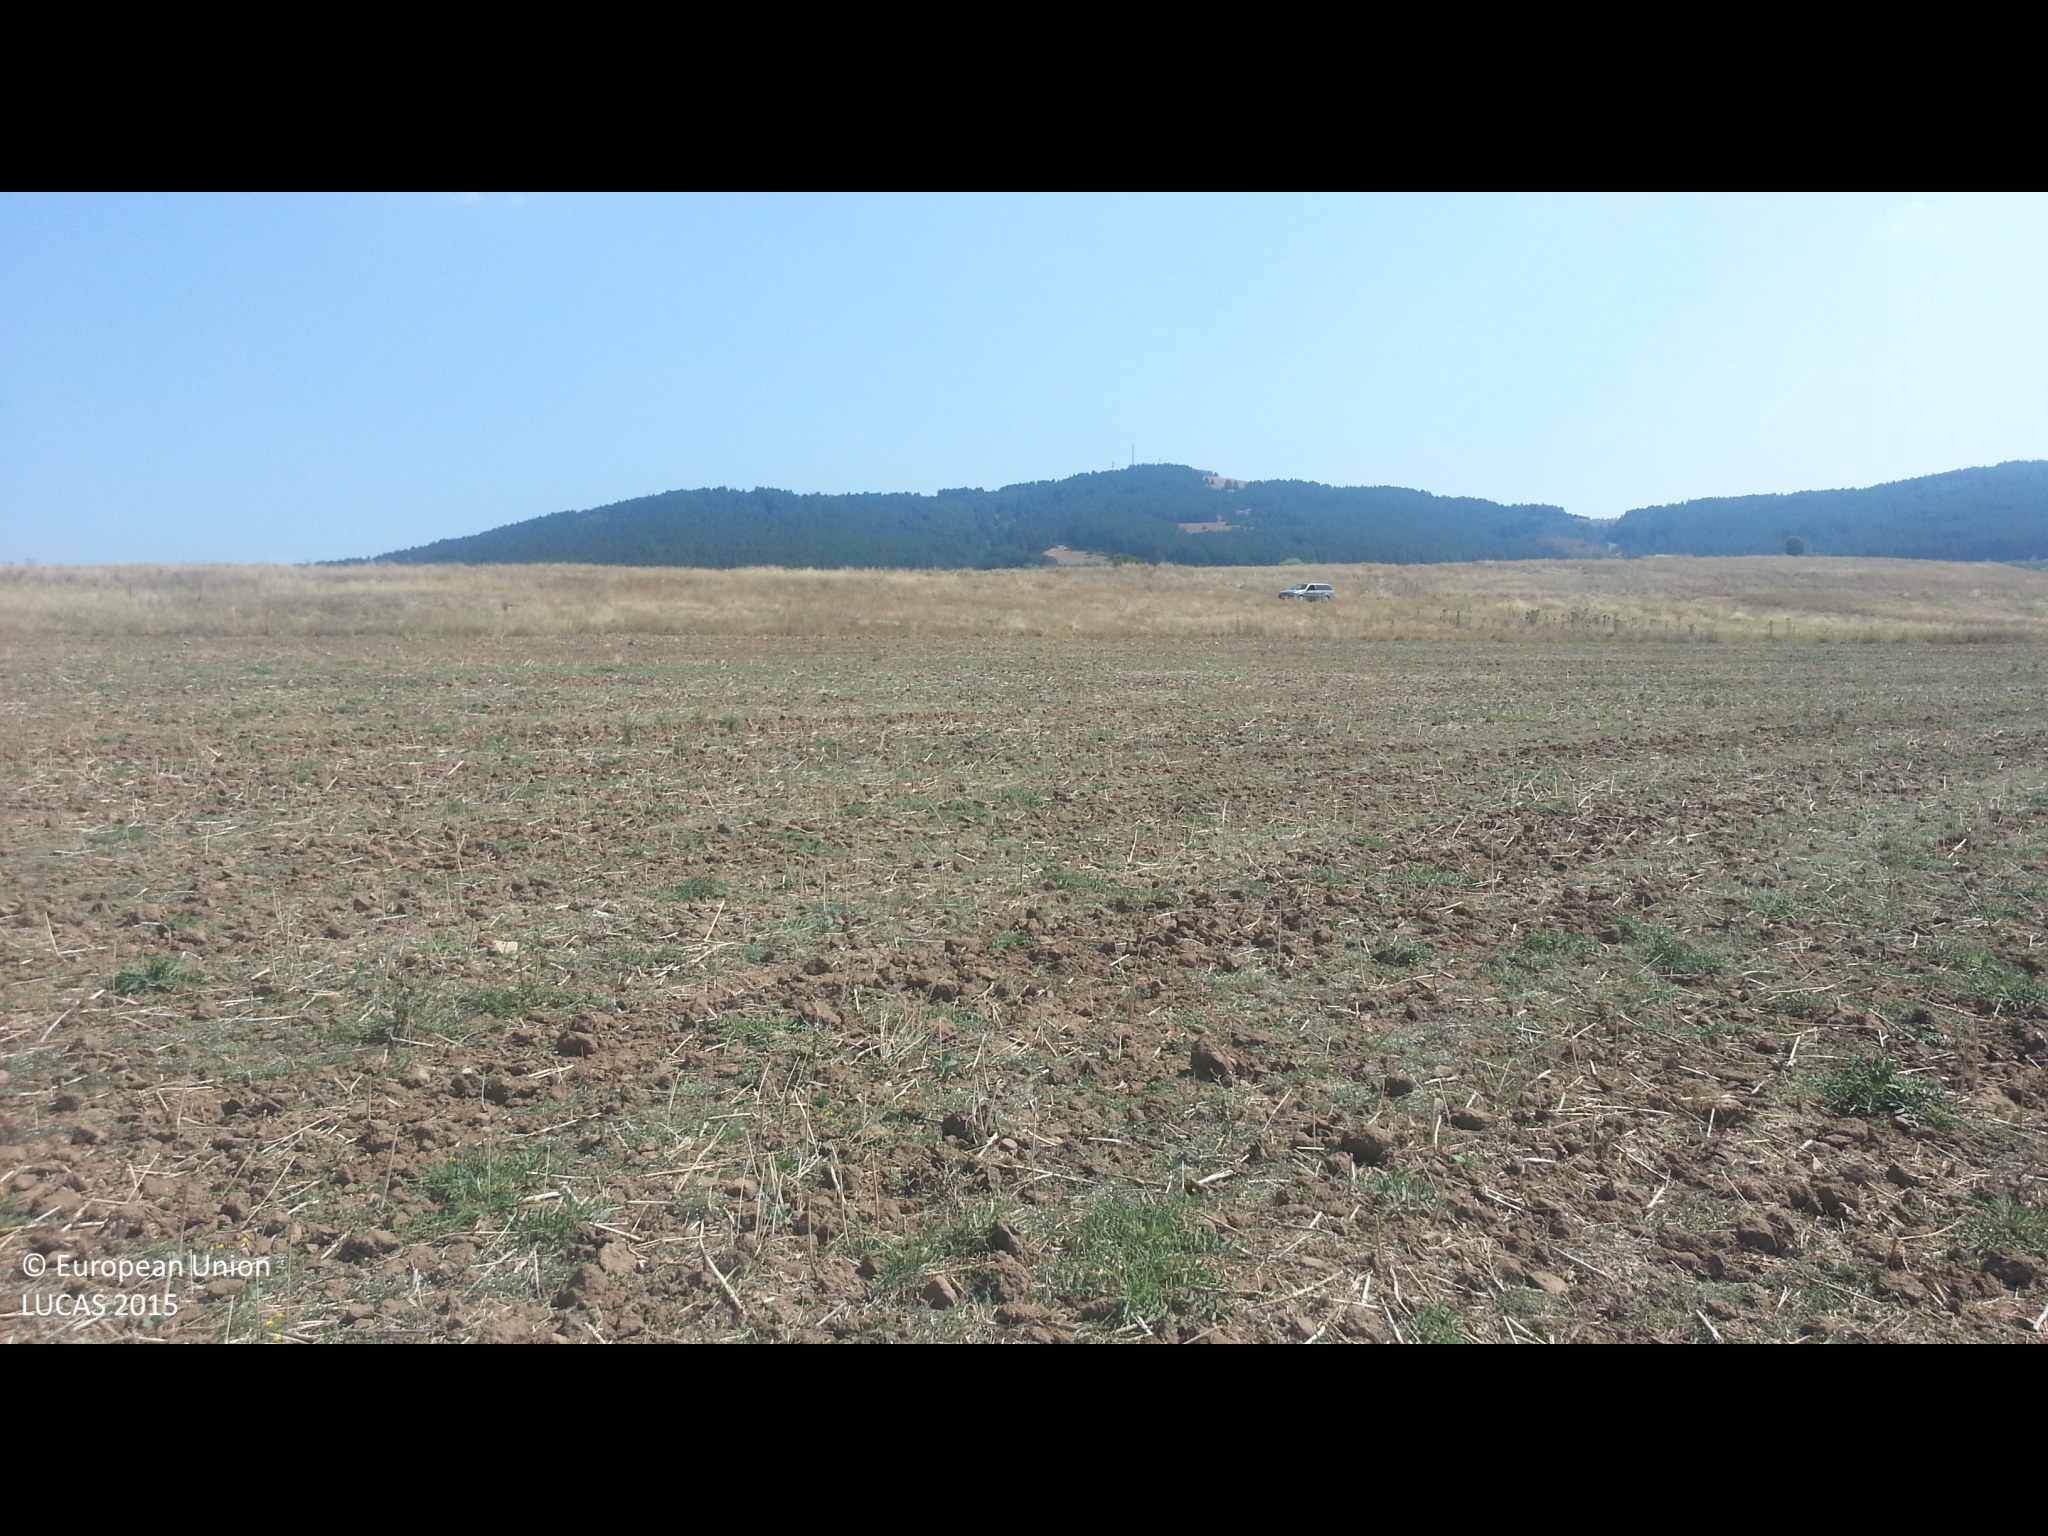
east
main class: Grassland
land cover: Spontaneously vegetated surfaces
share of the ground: 25 - 50 %
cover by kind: consolidated bare surface 65 %, herbaceous plants 35 %
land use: Agriculture (excluding fallow land and kitchen gardens)
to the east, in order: Spontaneously vegetated surfaces; Tracks; Grassland without tree/shrub cover
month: August
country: BG
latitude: 42.4421
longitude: 23.0731
